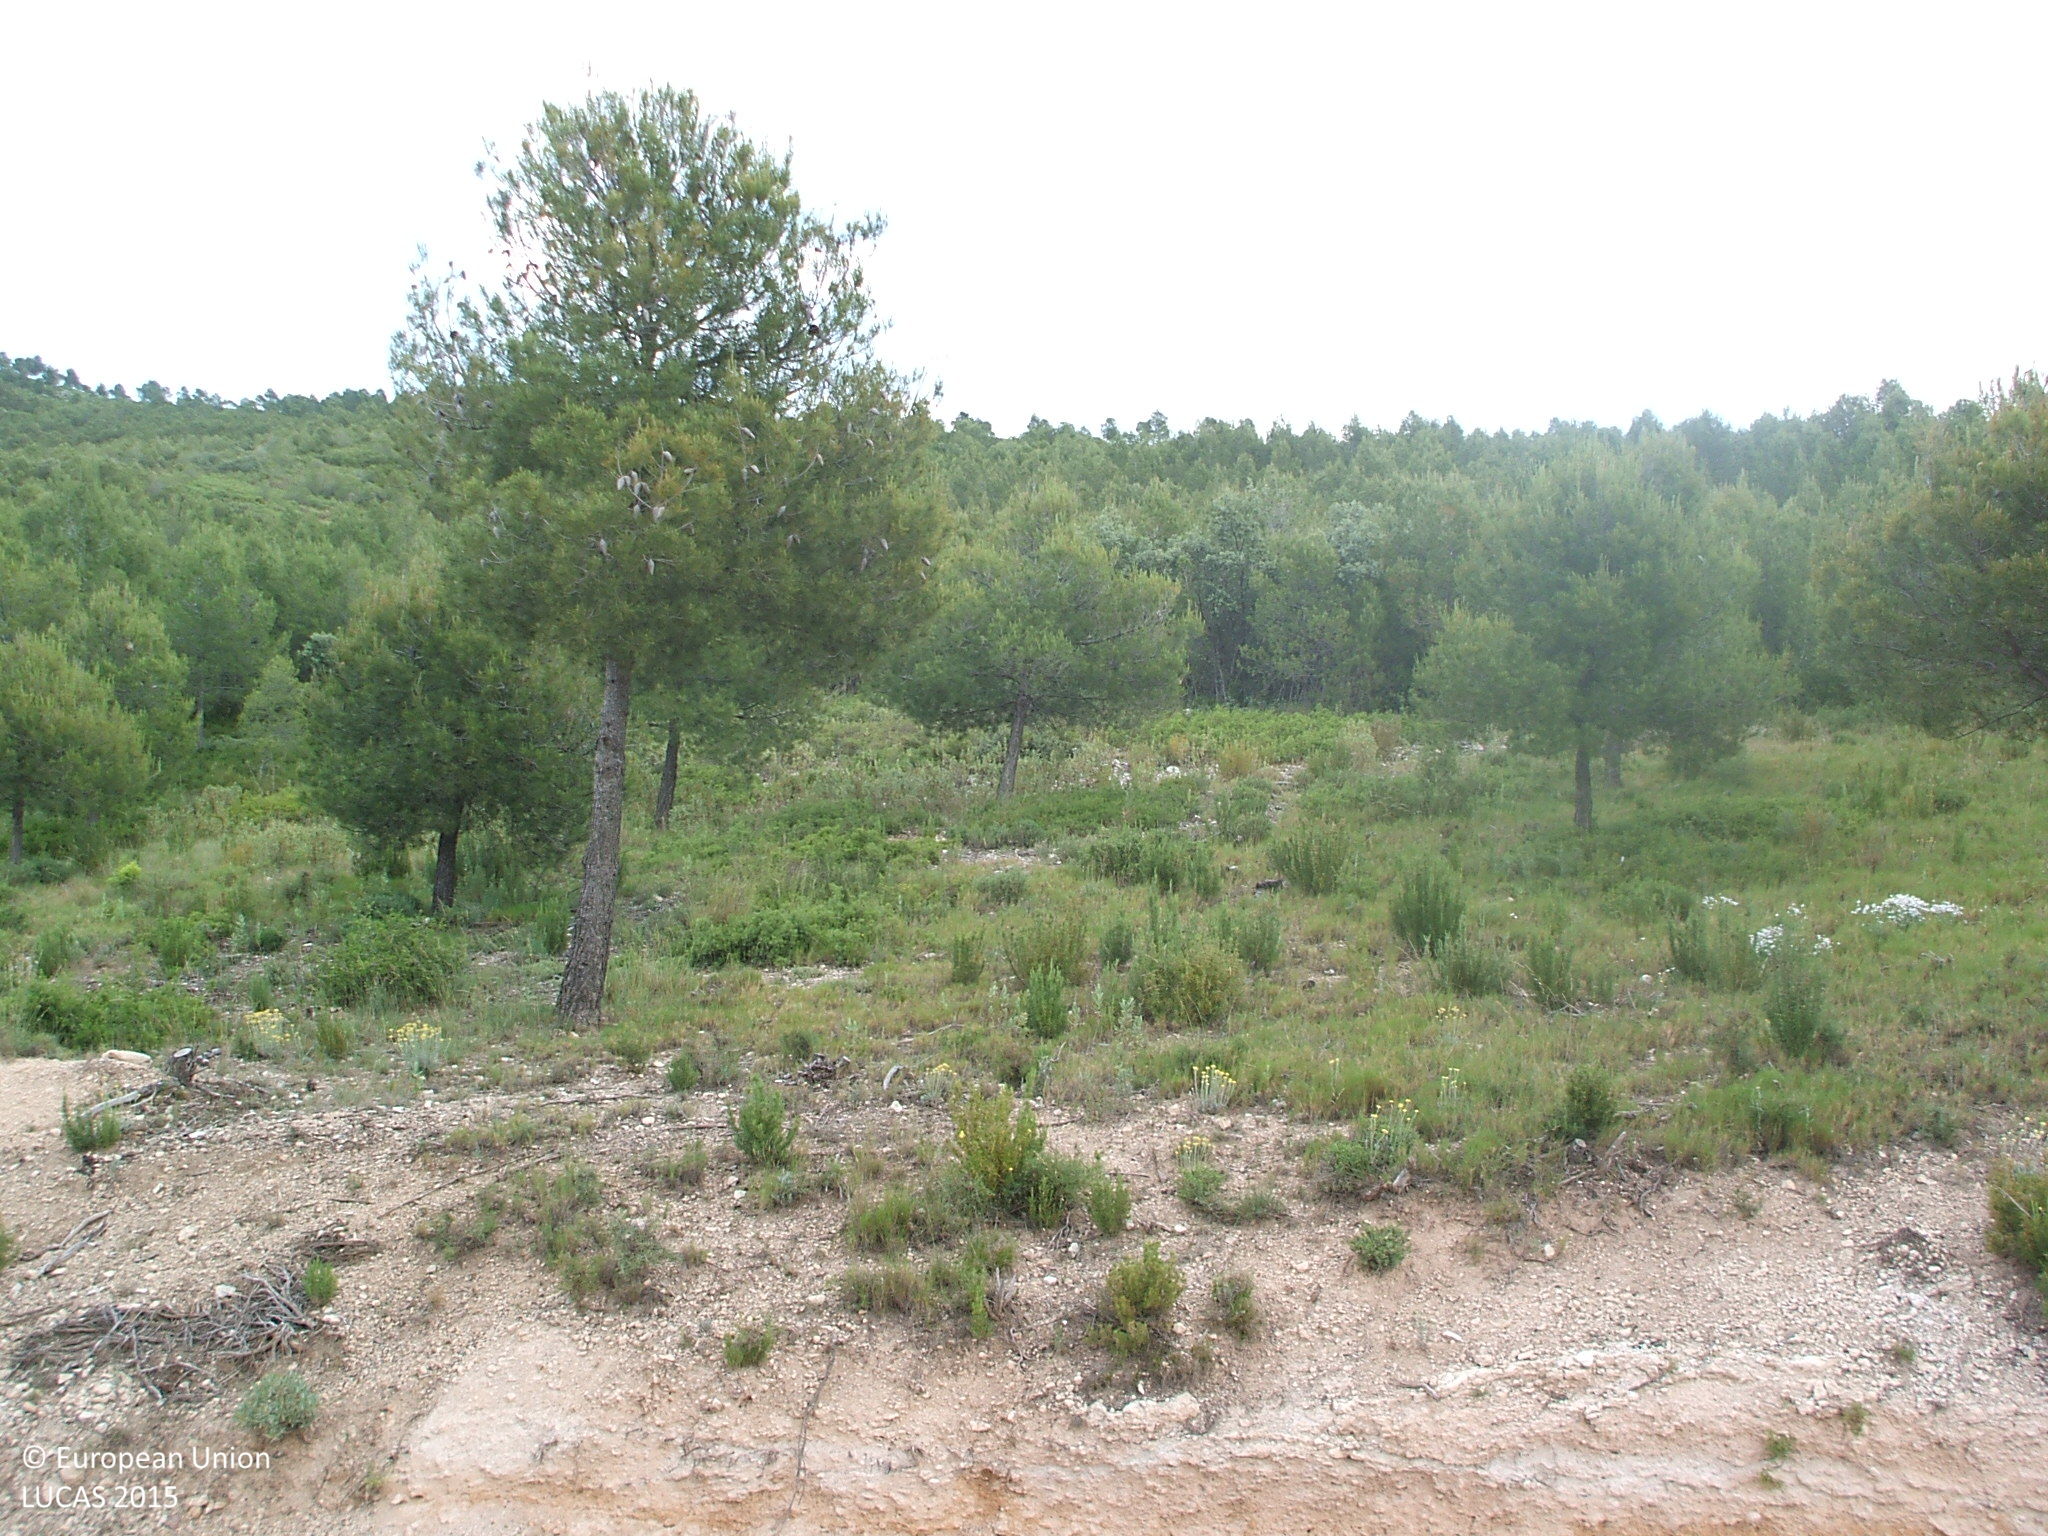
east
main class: Woodland
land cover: Pine dominated coniferous woodland
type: coniferous forest of the mediterranean region
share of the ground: > 75 %
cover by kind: coniferous forest trees 100 %
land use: Semi-natural and natural areas not in use
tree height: > 5 m
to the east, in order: Pine dominated coniferous woodland; Tracks; Shrubland with sparse tree cover; Pine dominated coniferous woodland
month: June
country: ES
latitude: 40.8865
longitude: -0.1573
